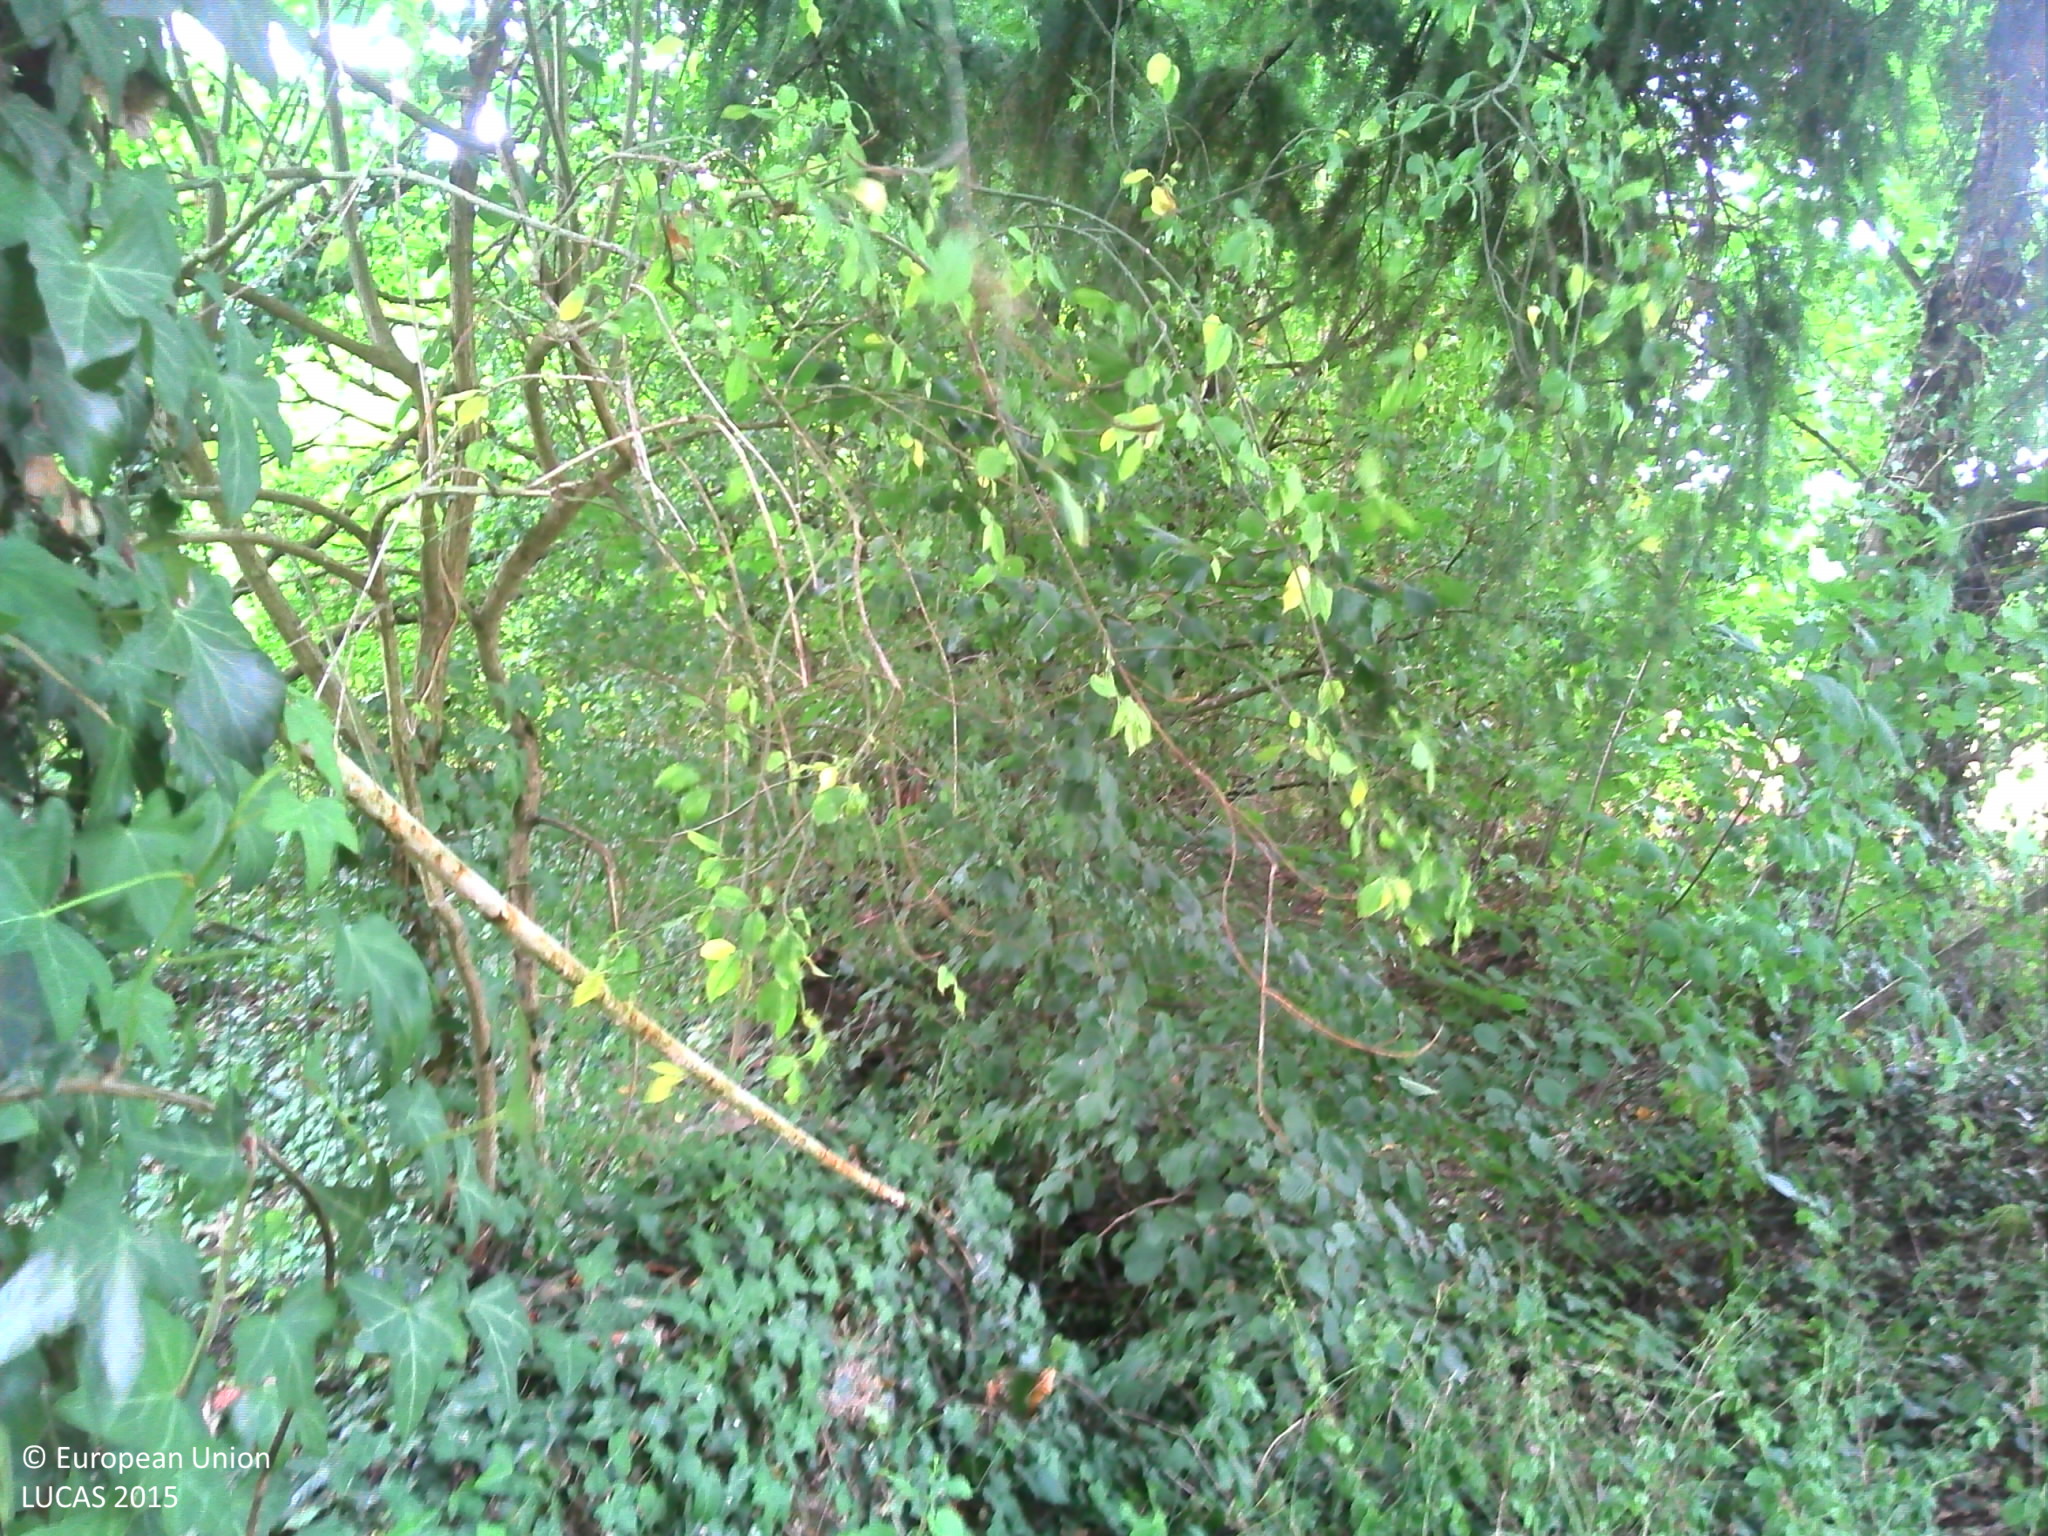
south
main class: Cropland
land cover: Arable land (only in case pi)
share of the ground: > 75 %
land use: Agriculture (excluding fallow land and kitchen gardens)
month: August
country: FR
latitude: 48.0038
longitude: 1.9857
